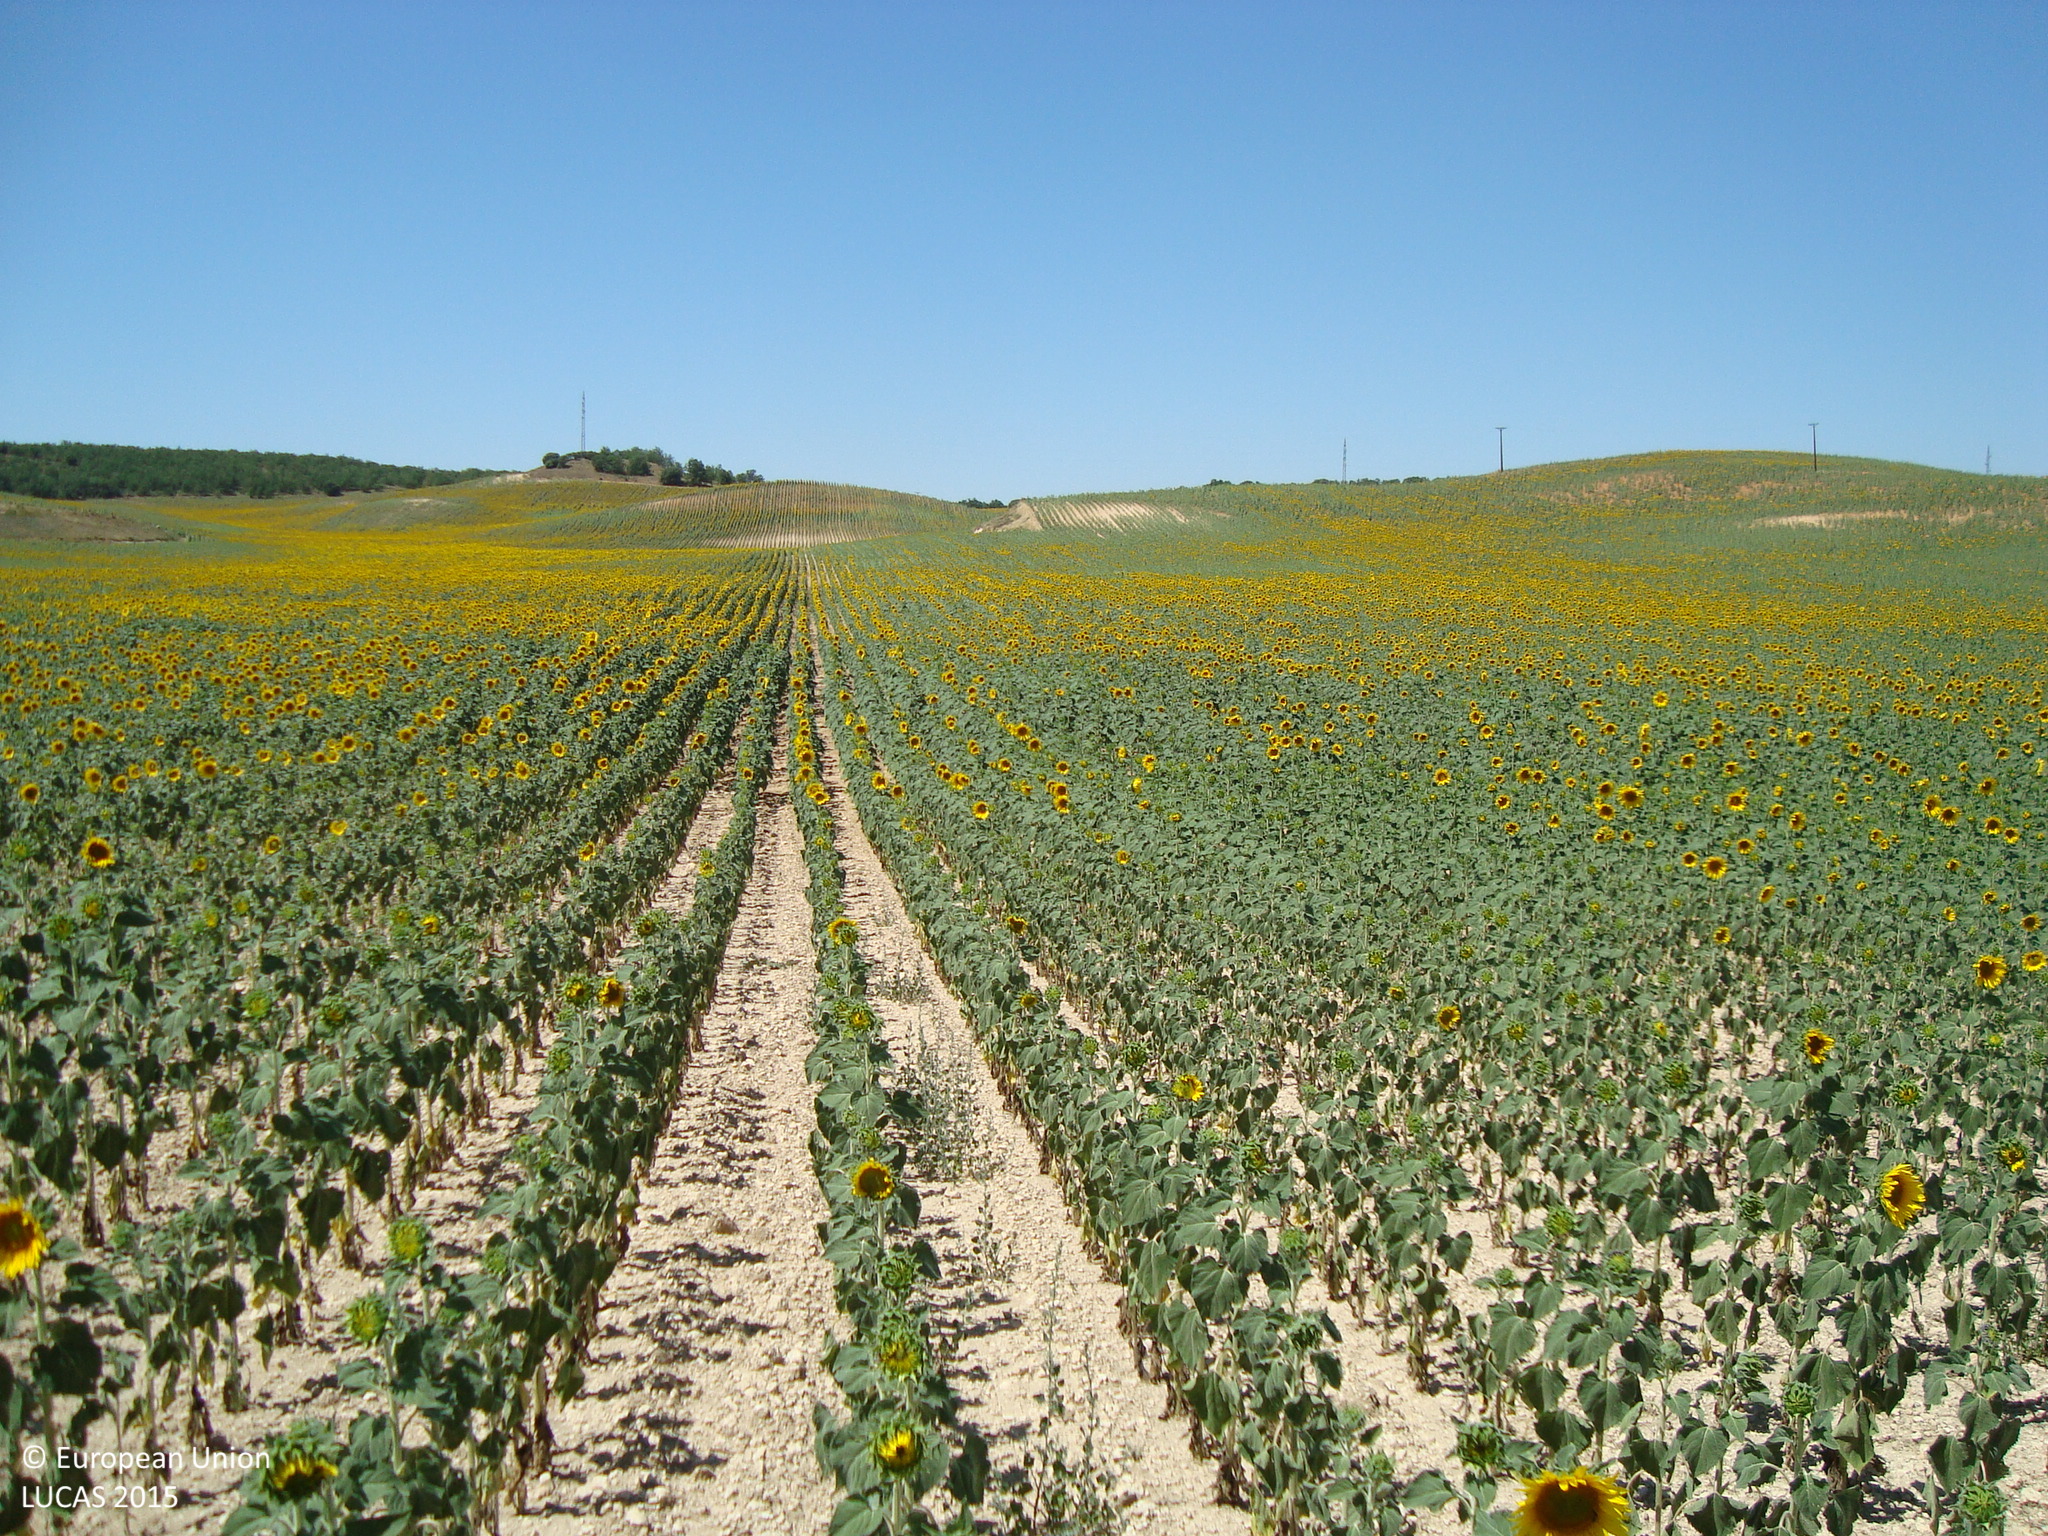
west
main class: Cropland
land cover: Sunflower
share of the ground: 50 - 75 %
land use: Agriculture (excluding fallow land and kitchen gardens)
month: July
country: ES
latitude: 41.8494
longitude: -3.6769
